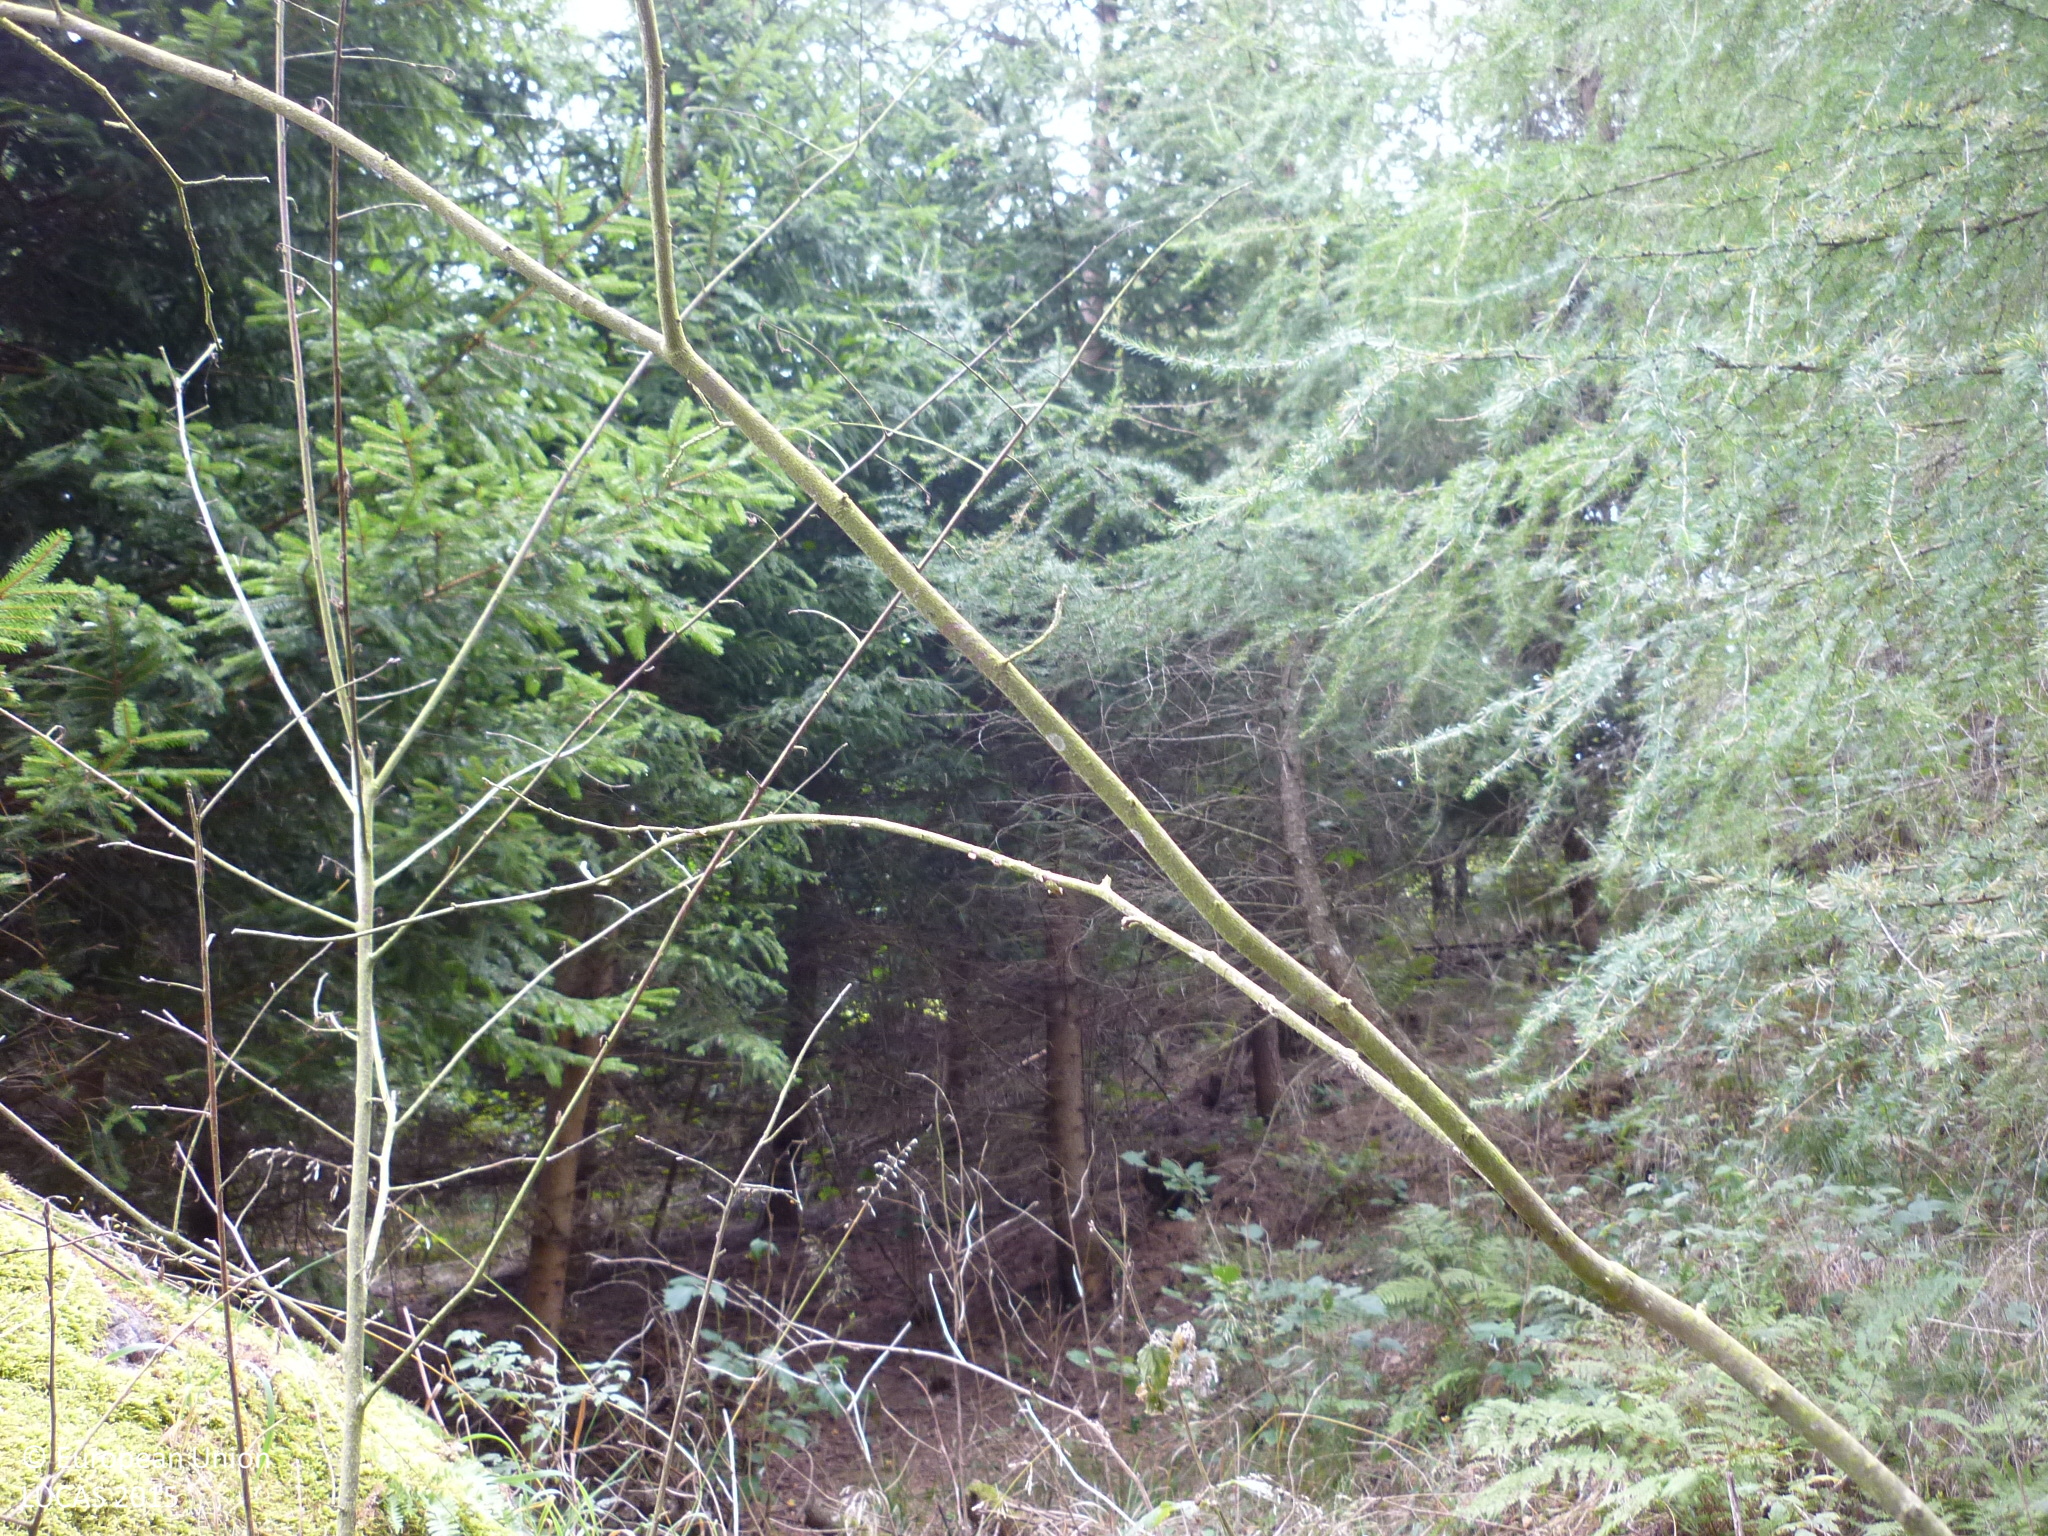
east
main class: Woodland
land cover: Spruce dominated coniferous woodland
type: alpine coniferous forest
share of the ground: 50 - 75 %
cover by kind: coniferous forest trees 65 %, herbaceous plants 20 %, broadleaved forest trees 10 %, lichens and mosses 5 %
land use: Forestry
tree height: > 5 m
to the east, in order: Spruce dominated coniferous woodland; Grassland with sparse tree/shrub cover; Spruce dominated coniferous woodland; Other mixed woodland; Spruce dominated mixed woodland; Tracks; Spruce dominated coniferous woodland; Tracks; Spruce dominated coniferous woodland; Spontaneously vegetated surfaces; Spruce dominated coniferous woodland
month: August
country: AT
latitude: 46.9439
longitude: 14.4517
